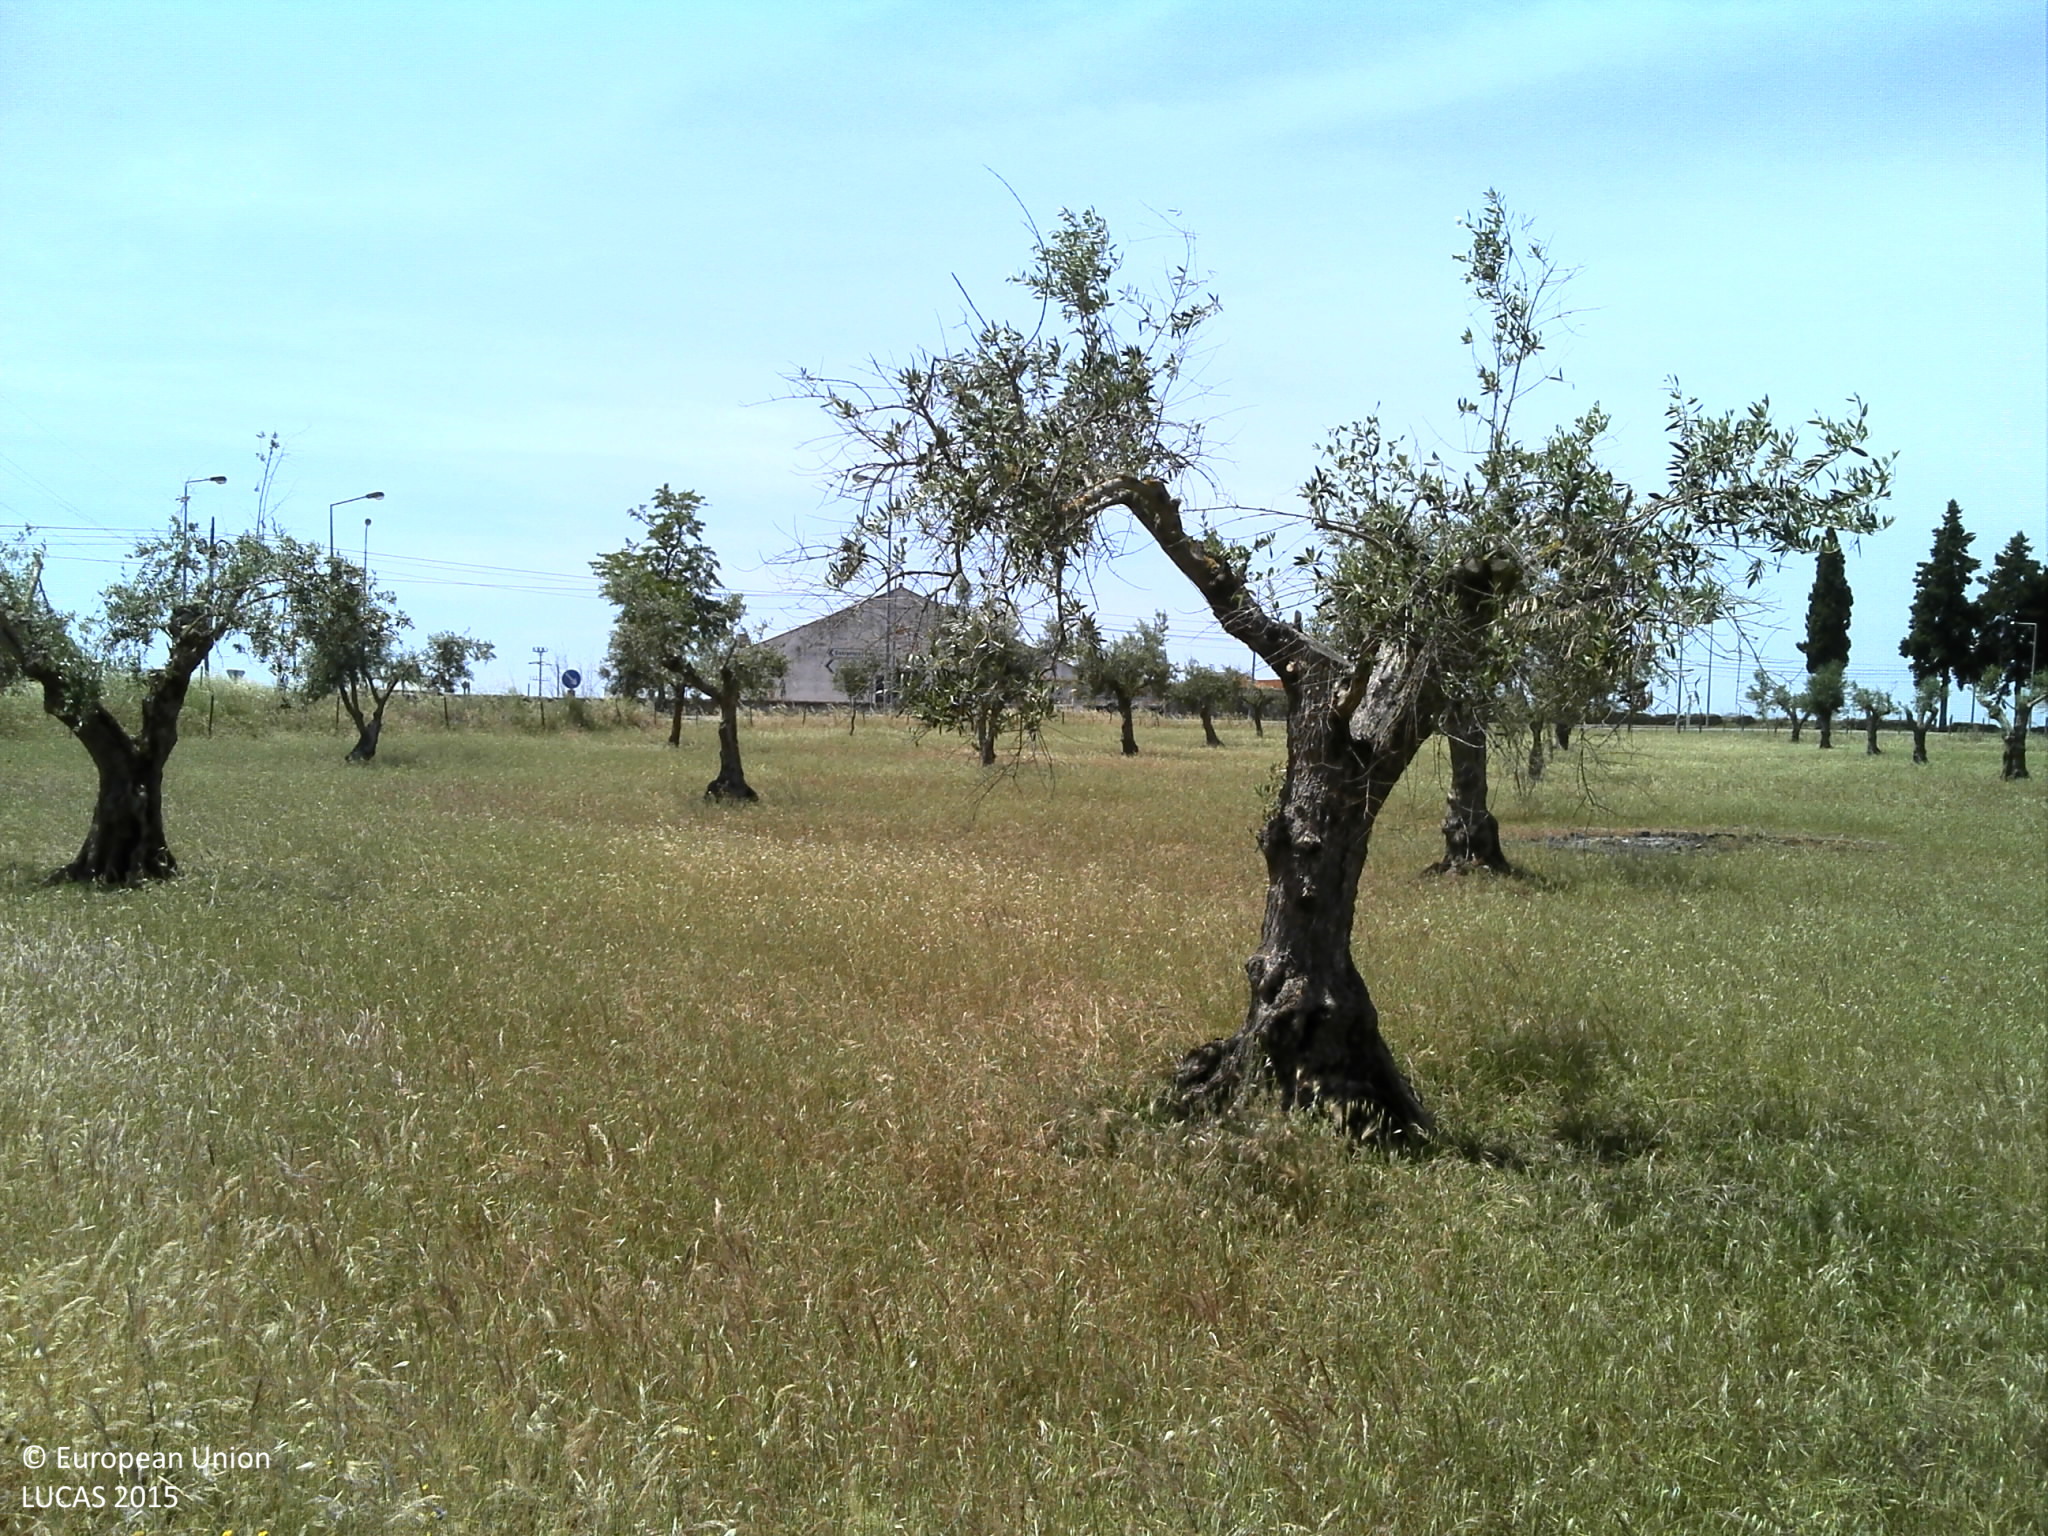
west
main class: Cropland
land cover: Olive groves
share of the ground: 10 - 25 %
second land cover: Grassland without tree/shrub cover
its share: 25 - 50 %
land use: Agriculture (excluding fallow land and kitchen gardens)
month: May
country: PT
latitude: 39.1877
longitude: -7.6540
